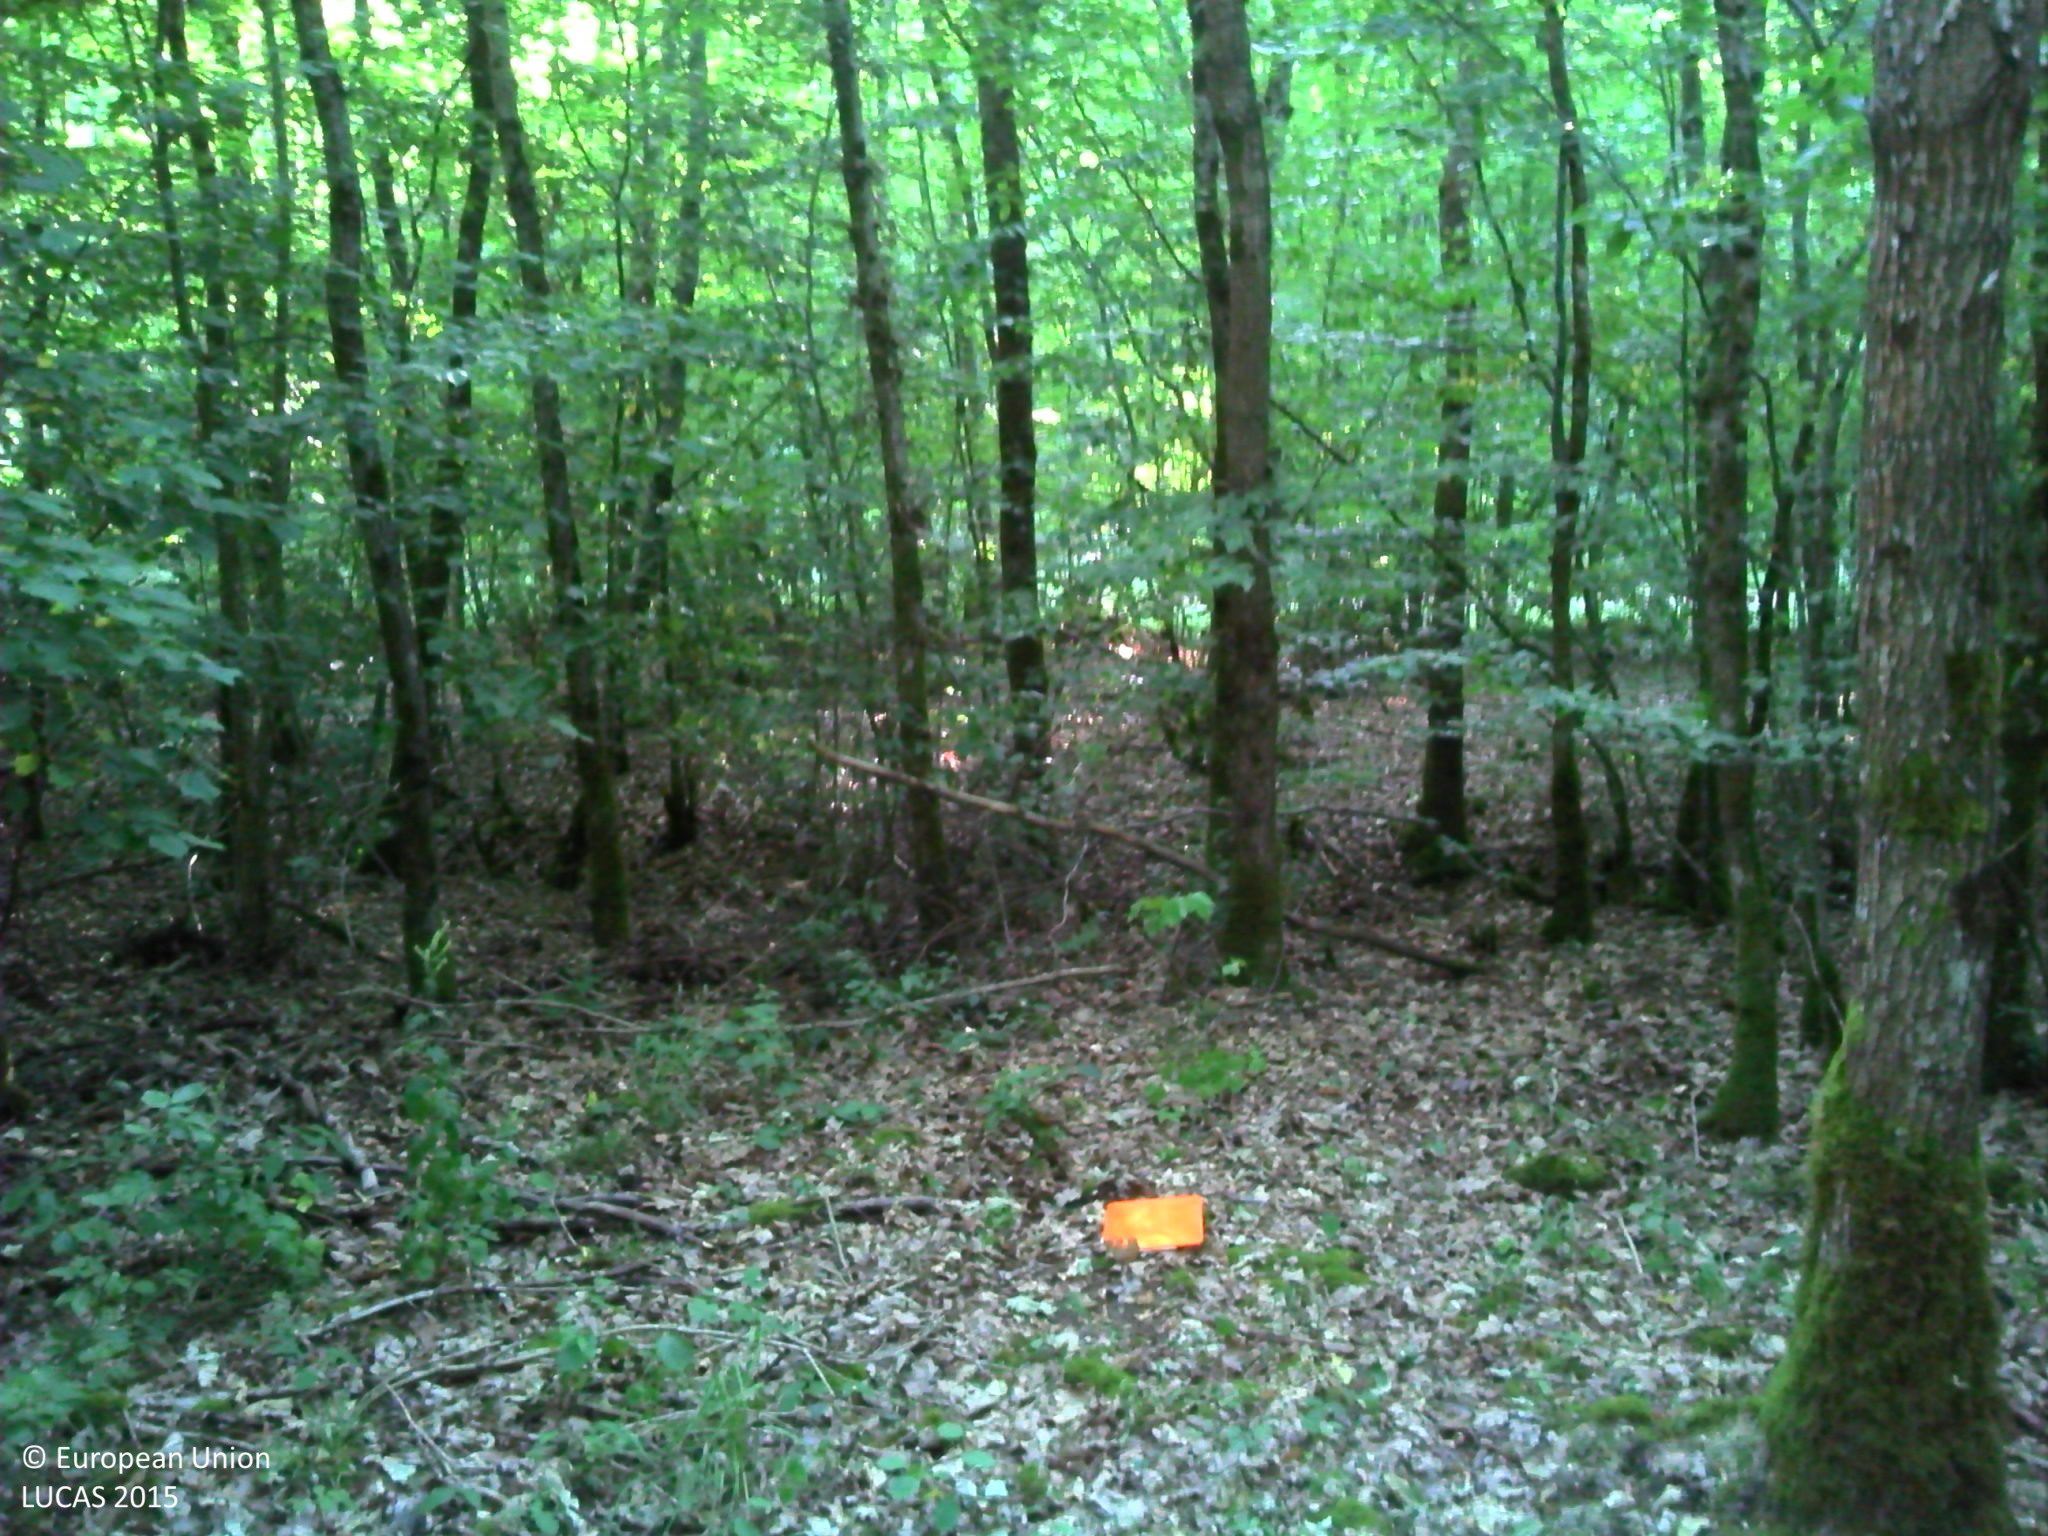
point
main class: Woodland
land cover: Broadleaved woodland
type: acidophilous oak and oak-birch forest
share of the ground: > 75 %
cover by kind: broadleaved forest trees 90 %, herbaceous plants 5 %, lichens and mosses 5 %
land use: Forestry
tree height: > 5 m
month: July
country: FR
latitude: 48.5305
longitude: 6.0322
